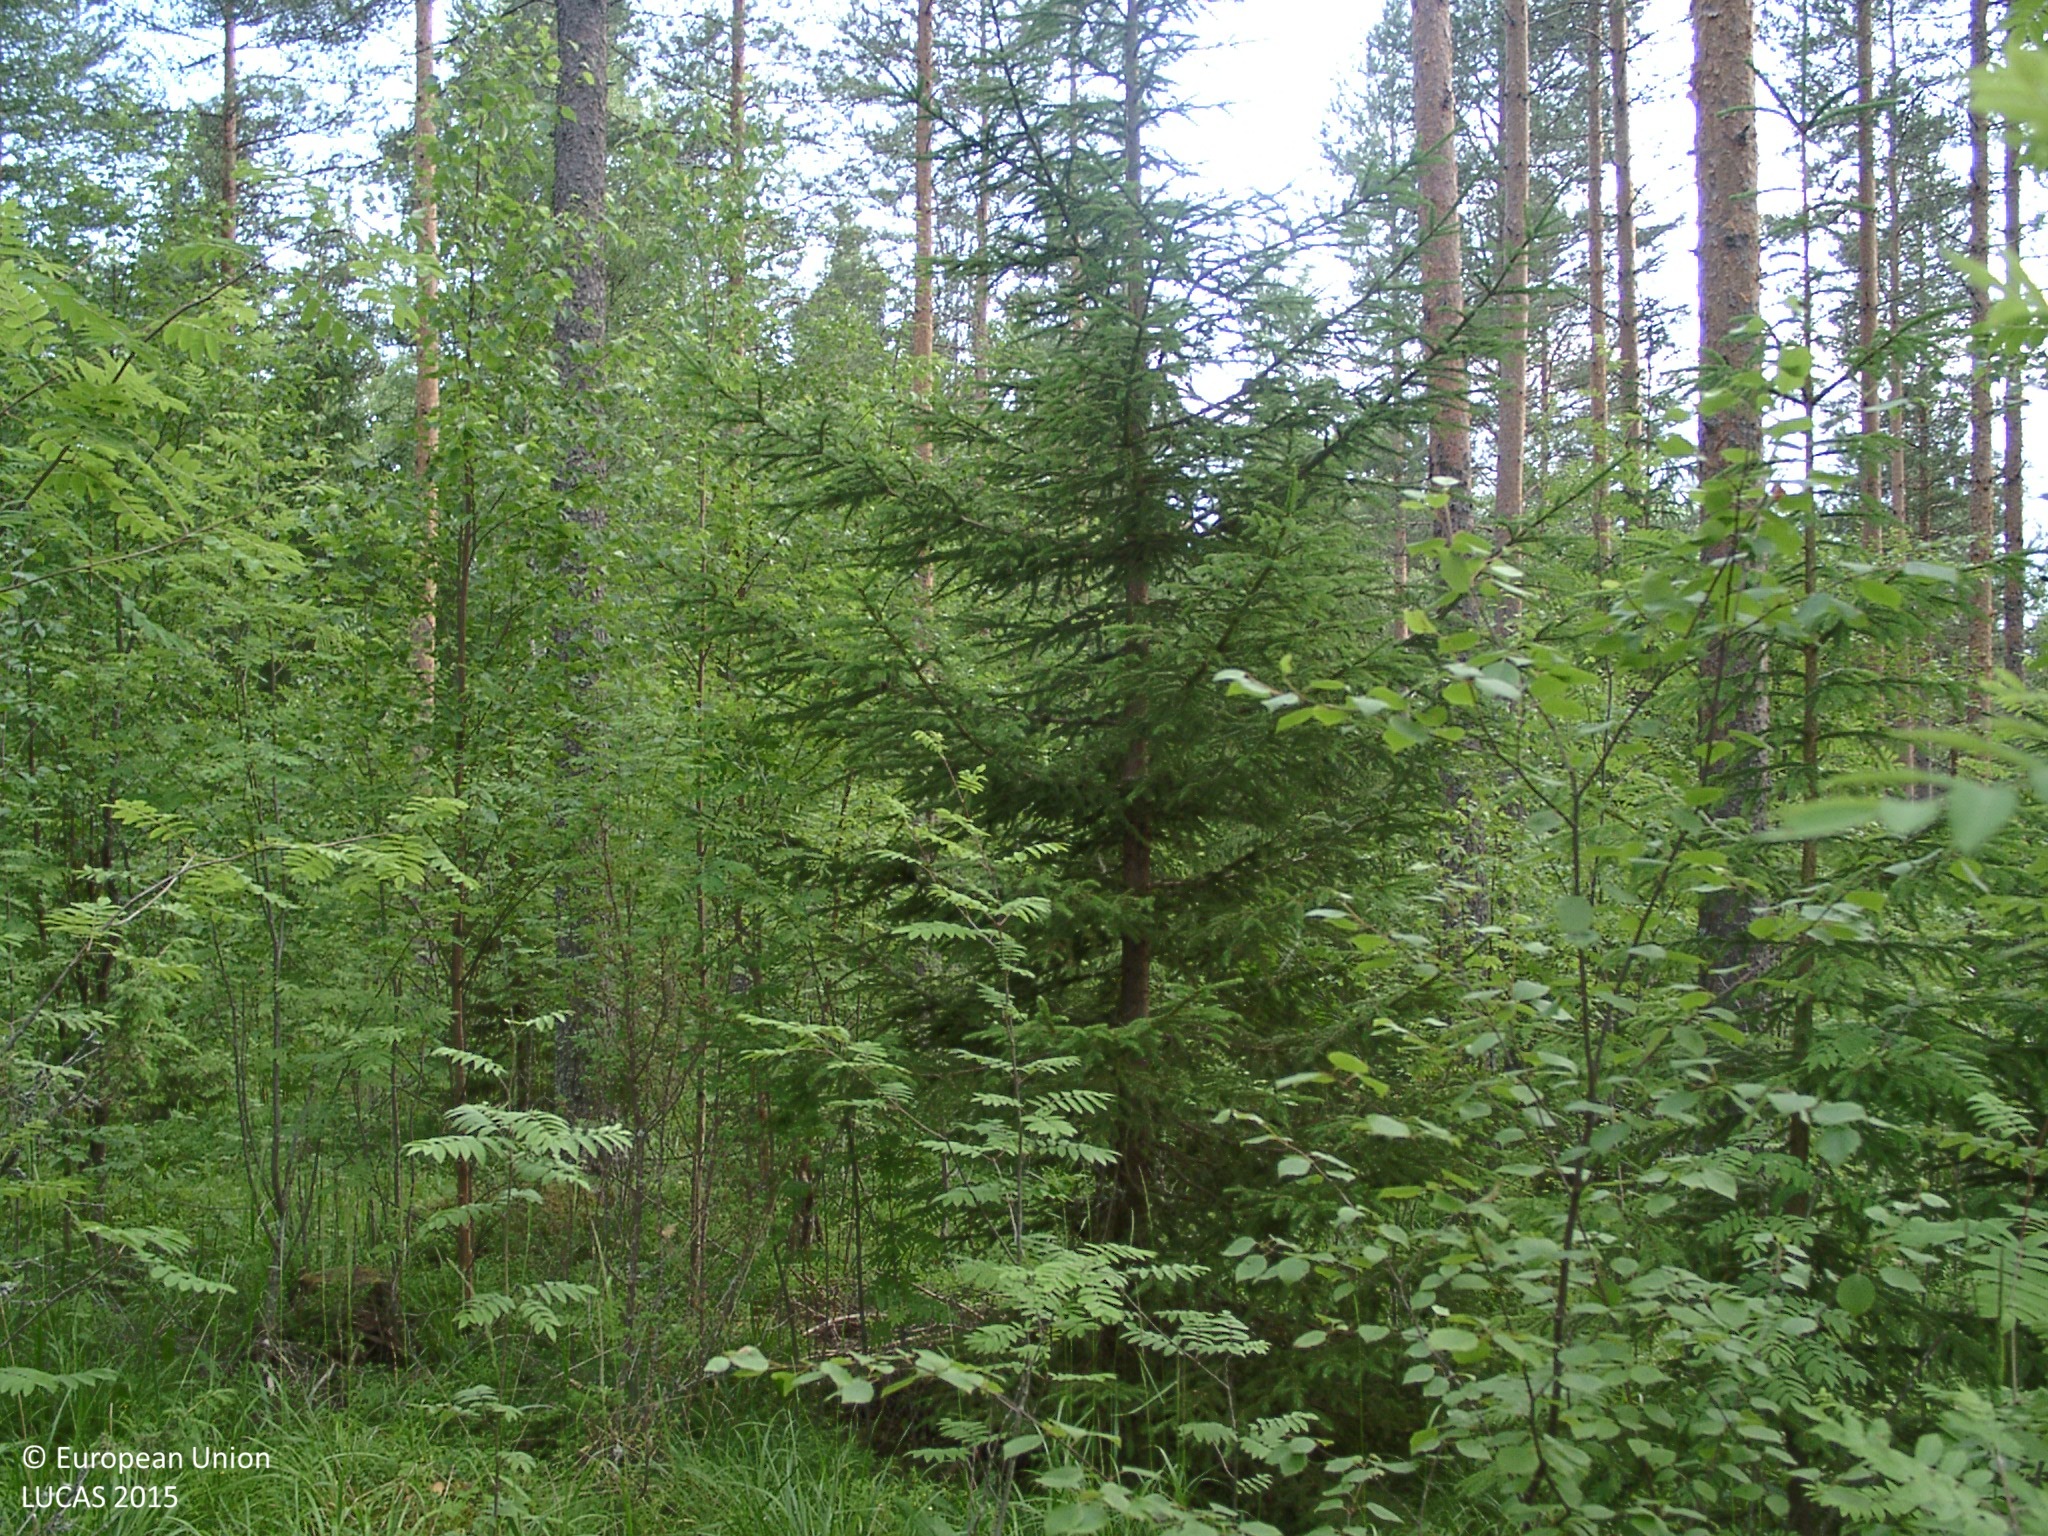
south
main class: Woodland
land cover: Other mixed woodland
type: boreal forest
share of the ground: 50 - 75 %
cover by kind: coniferous forest trees 50 %, broadleaved forest trees 20 %, shrubs 15 %, herbaceous plants 10 %, lichens and mosses 5 %
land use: Semi-natural and natural areas not in use
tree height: > 5 m
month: July
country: FI
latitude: 61.5800
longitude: 25.1617
